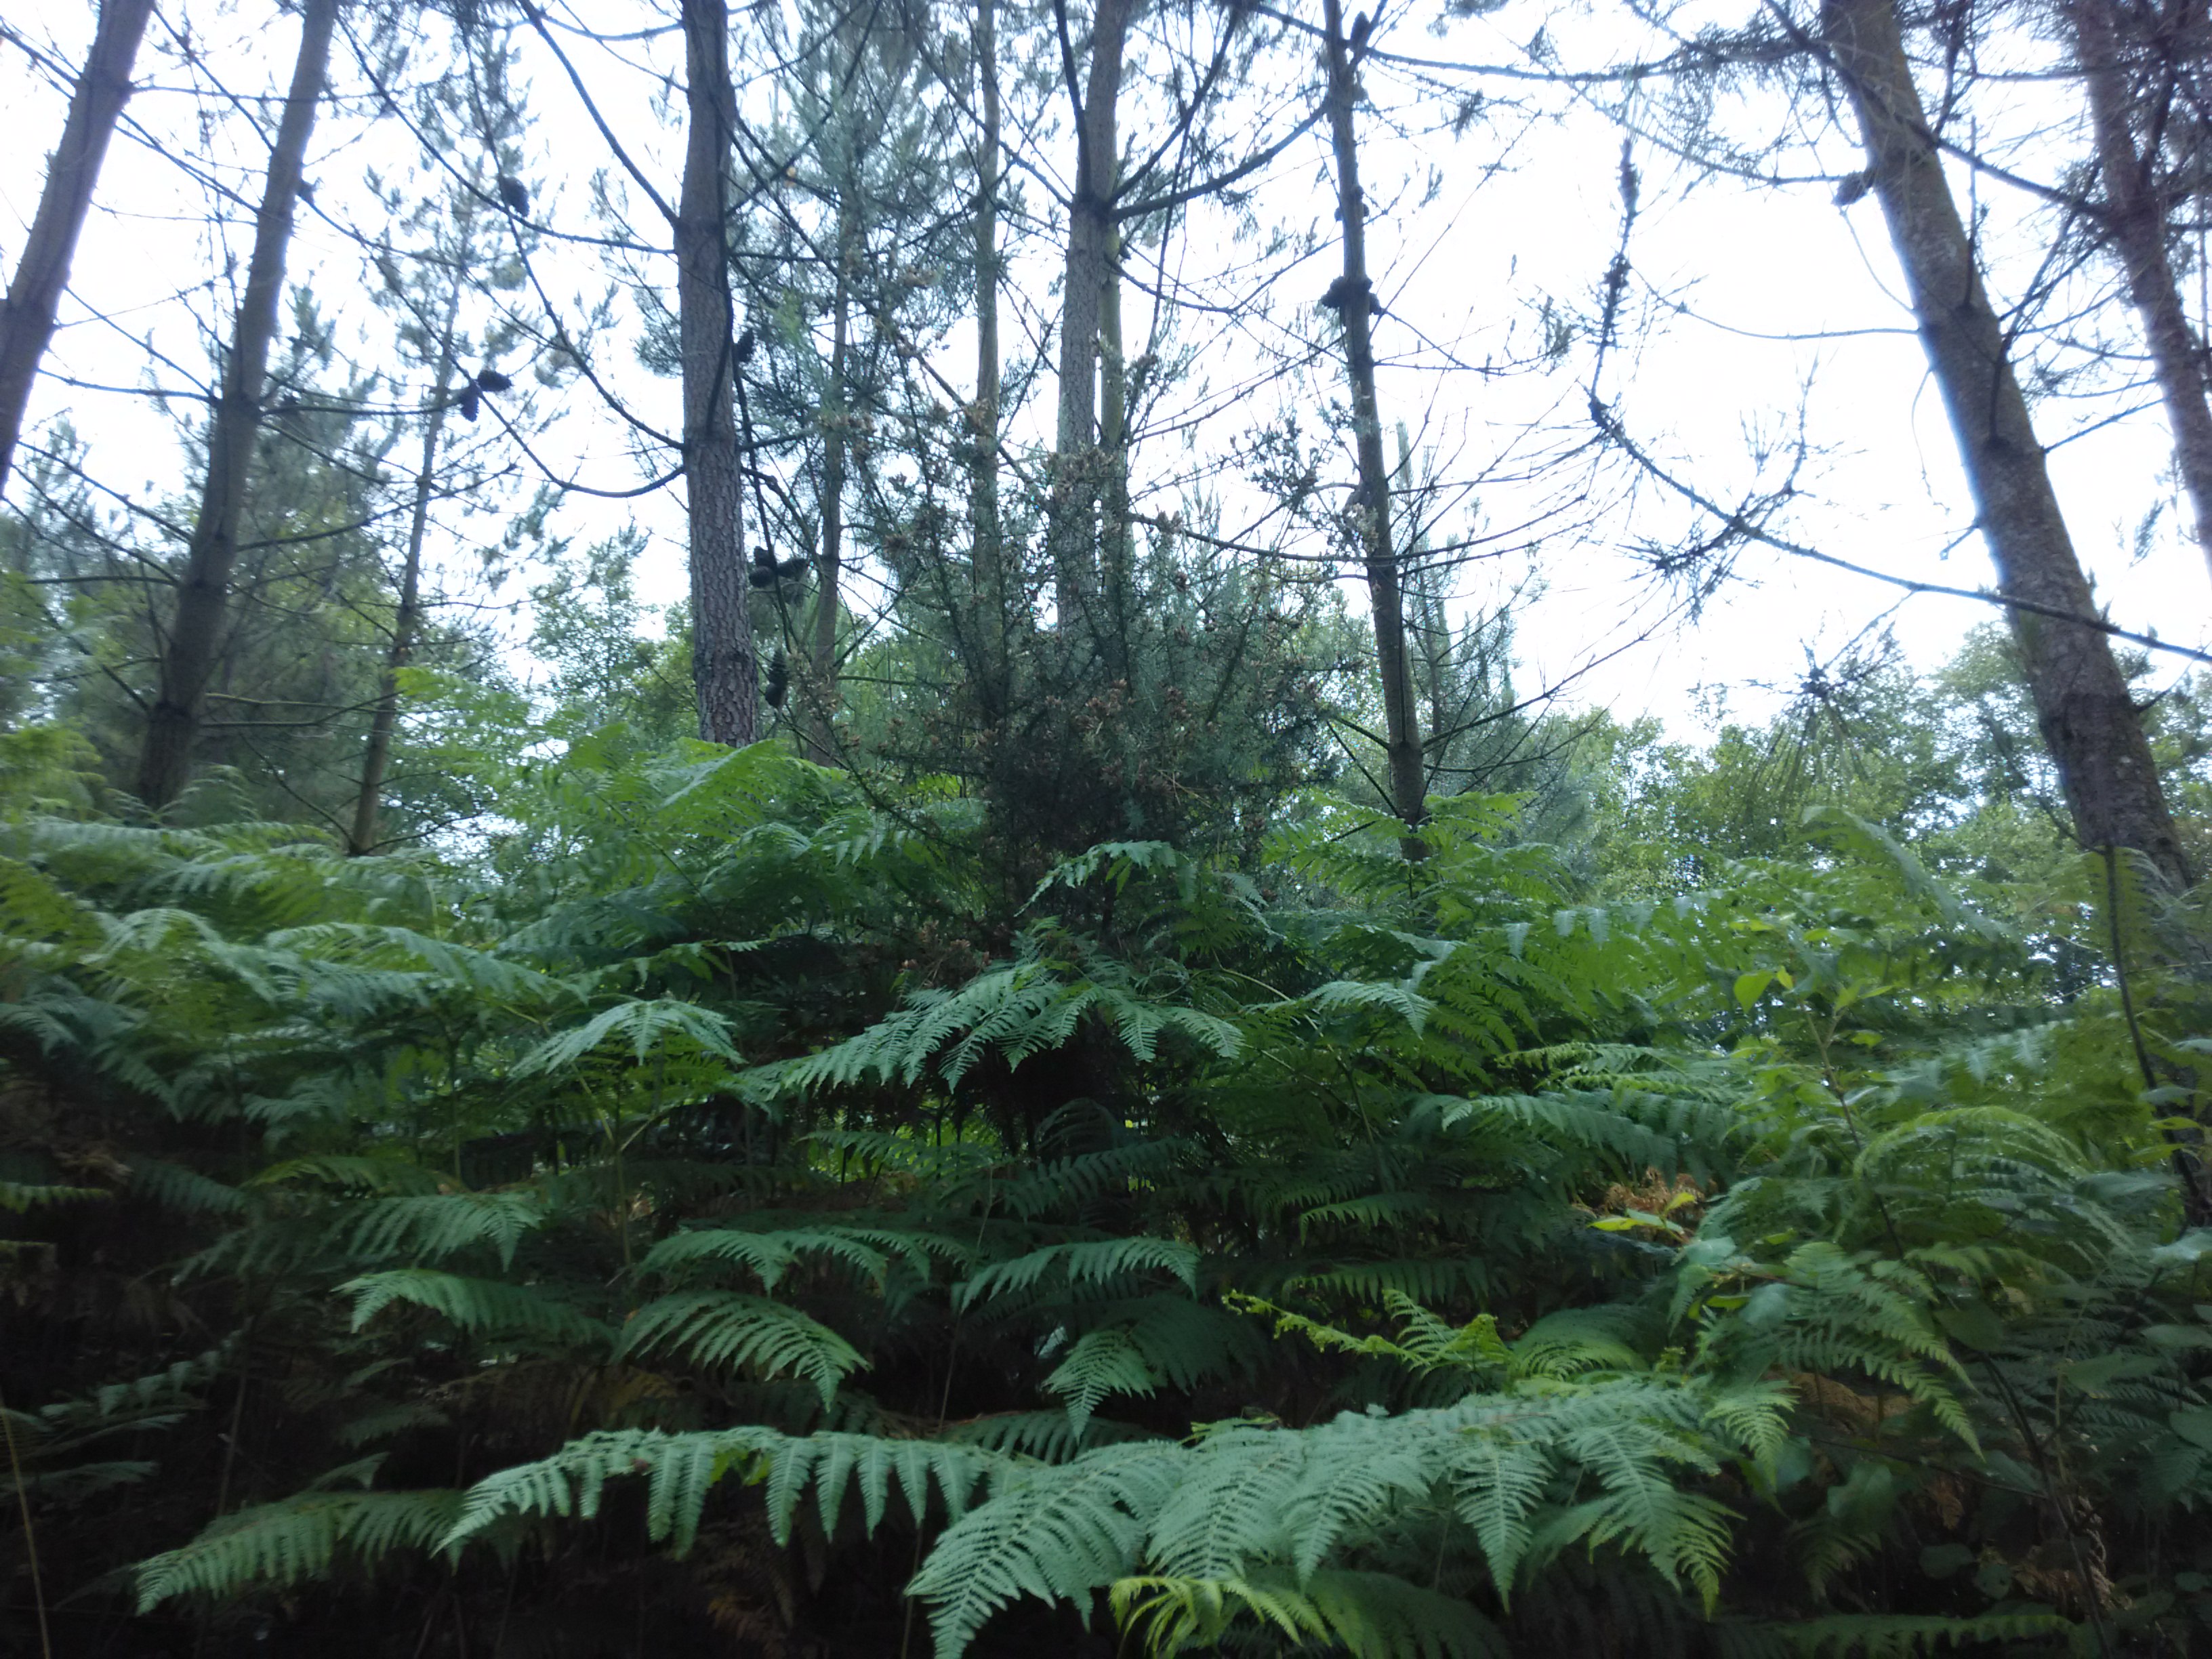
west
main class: Woodland
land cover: Pine dominated coniferous woodland
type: exotic forest
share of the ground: > 75 %
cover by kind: coniferous forest trees 90 %, unconsolidated bare surface 10 %
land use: Forestry
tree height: > 5 m
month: July
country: ES
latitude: 43.0934
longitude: -2.3969
